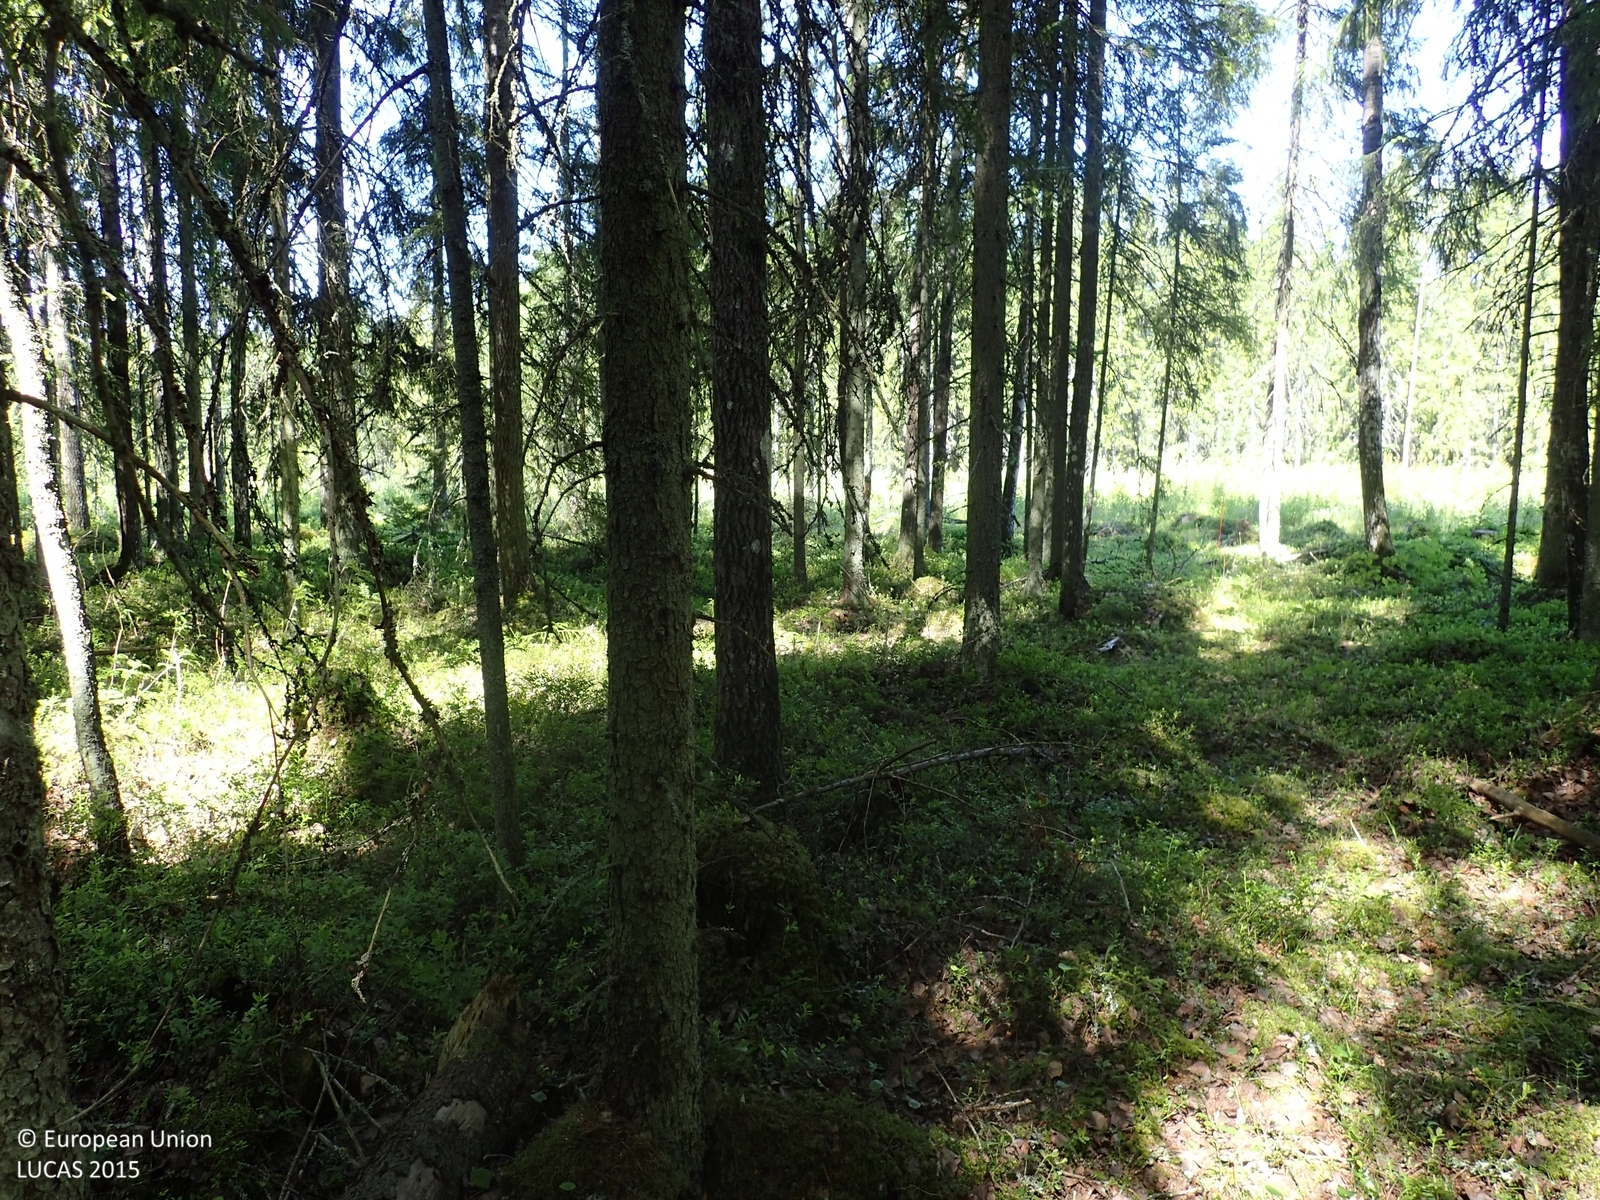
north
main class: Woodland
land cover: Spruce dominated mixed woodland
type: boreal forest
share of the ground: > 75 %
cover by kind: coniferous forest trees 60 %, broadleaved forest trees 20 %, shrubs 15 %, lichens and mosses 5 %
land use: Forestry
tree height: > 5 m
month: July
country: FI
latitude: 62.5509
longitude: 21.5358
